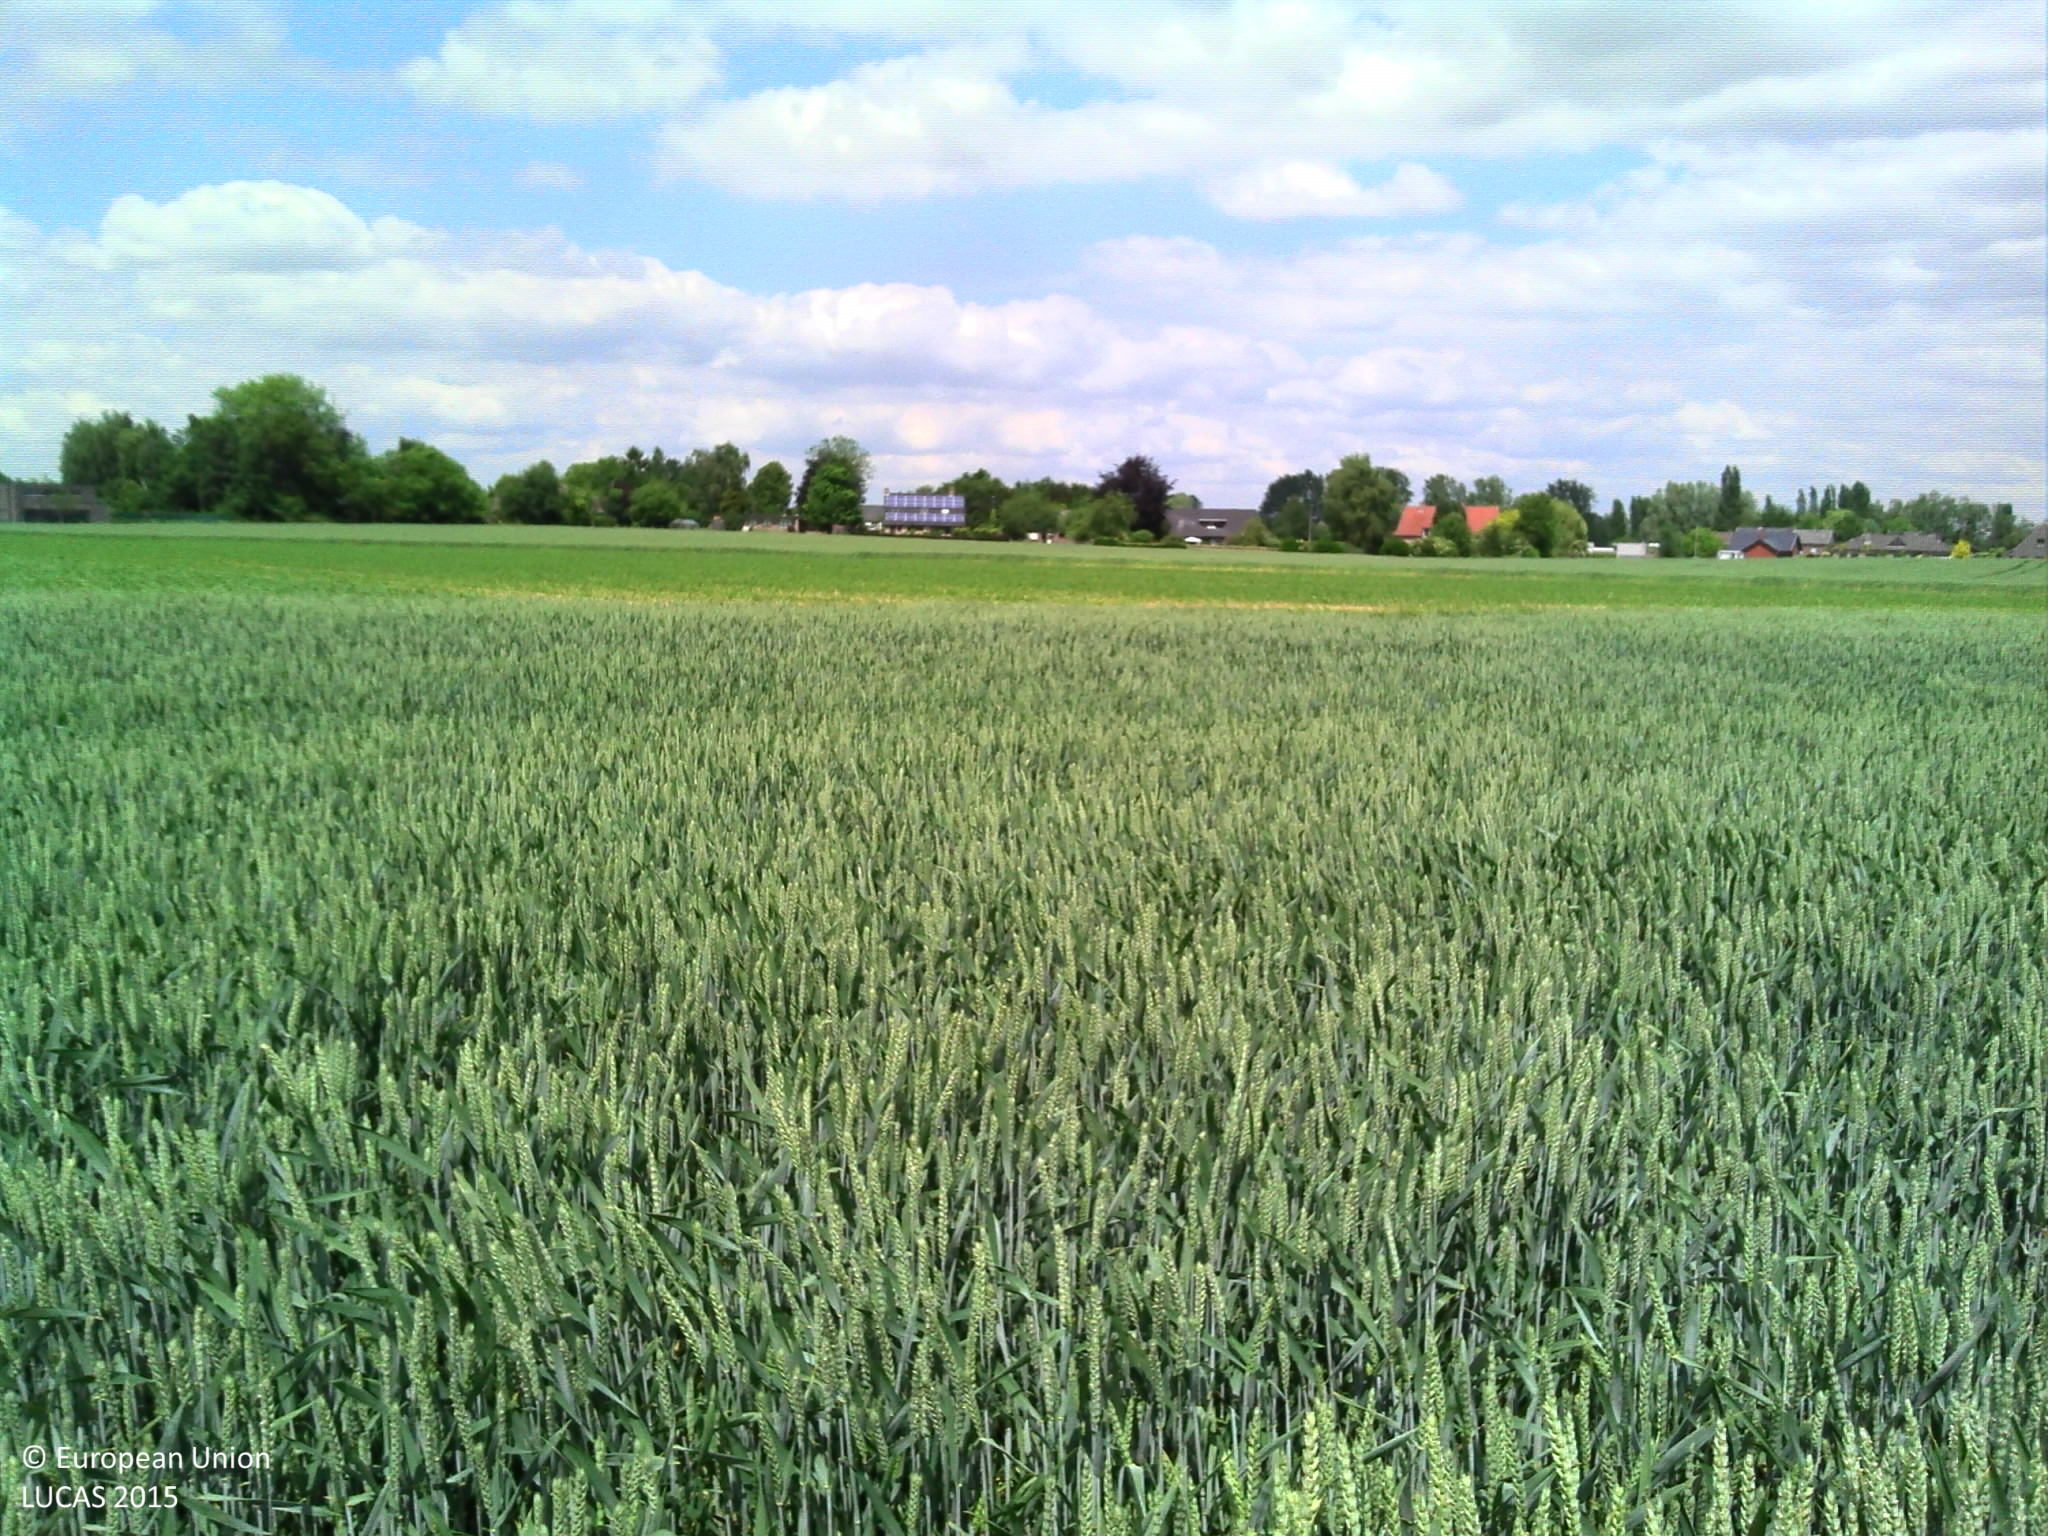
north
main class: Cropland
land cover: Common wheat
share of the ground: > 75 %
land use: Agriculture (excluding fallow land and kitchen gardens)
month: June
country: BE
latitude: 50.9067
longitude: 3.6073
